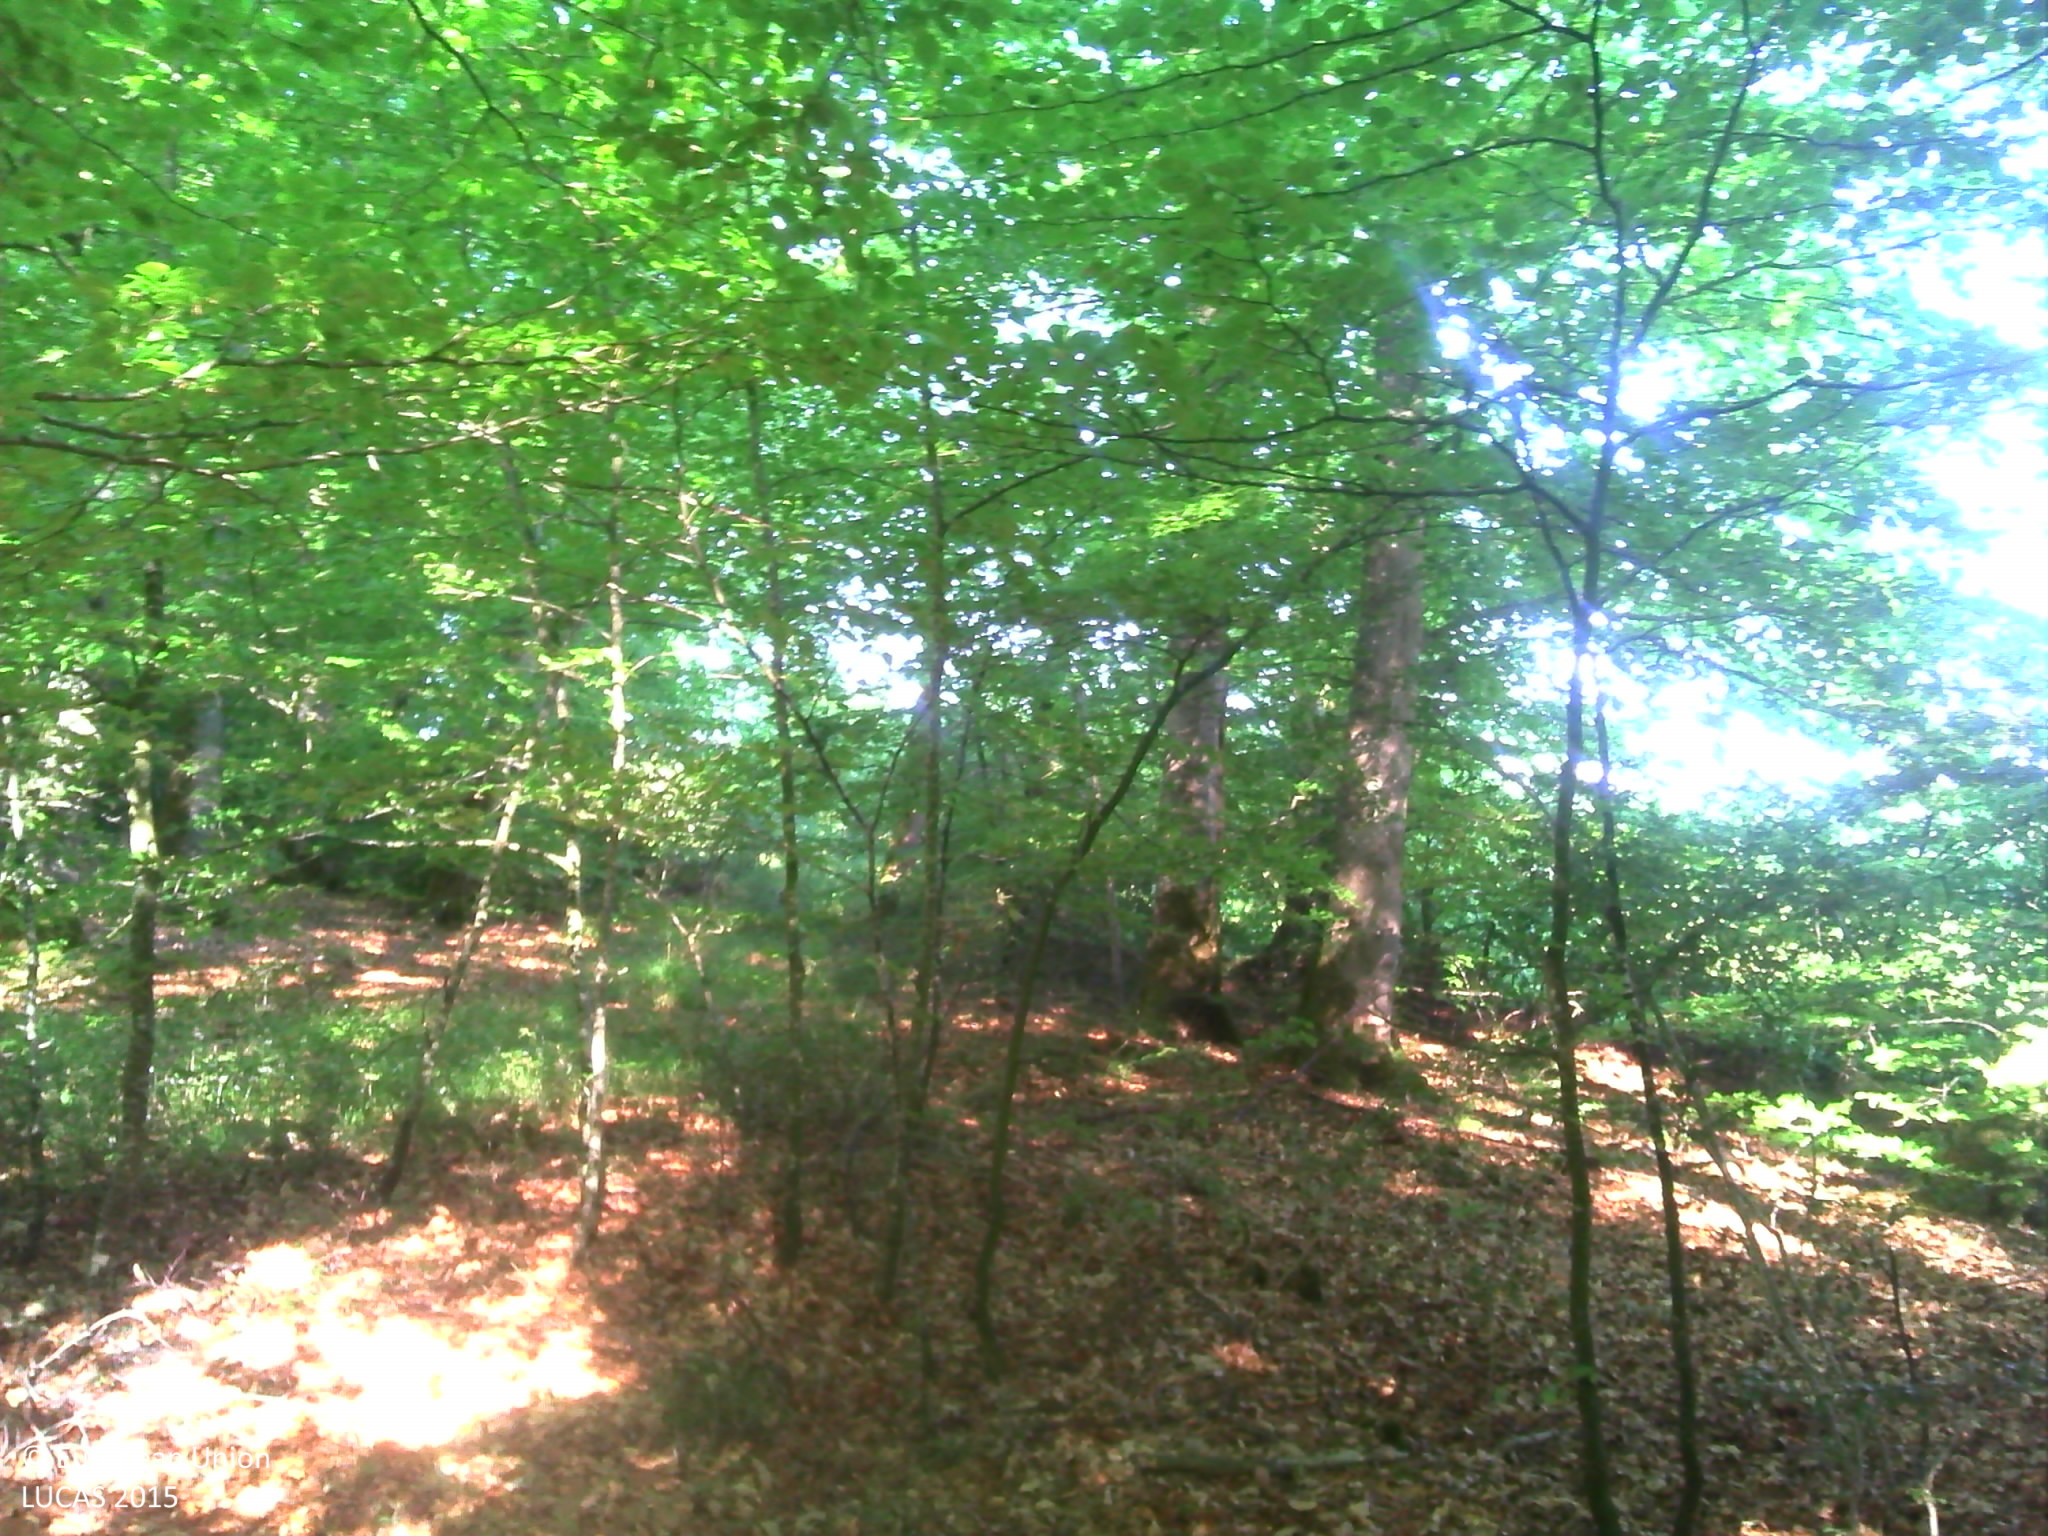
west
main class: Woodland
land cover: Broadleaved woodland
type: acidophilous oak and oak-birch forest
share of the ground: > 75 %
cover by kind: broadleaved forest trees 95 %, herbaceous plants 5 %
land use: Forestry
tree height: > 5 m
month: May
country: LU
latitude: 49.8178
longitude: 6.2886
